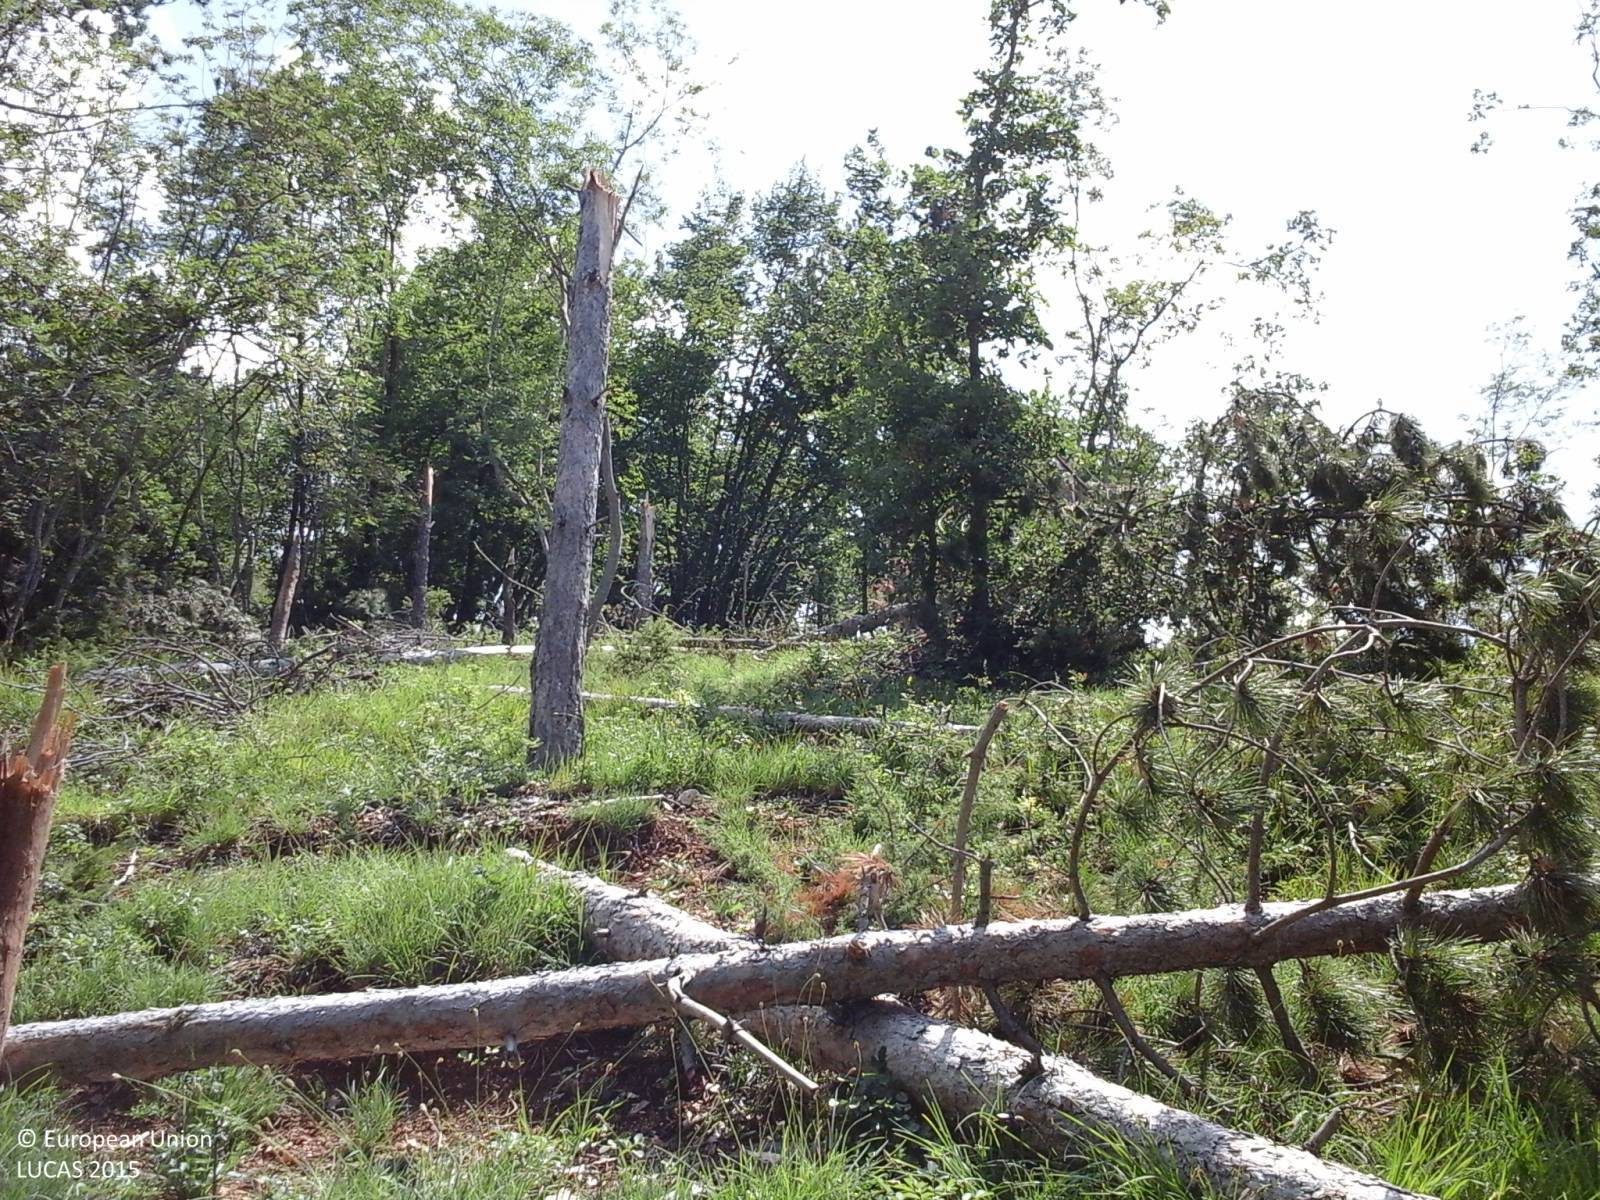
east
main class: Woodland
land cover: Broadleaved woodland
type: thermophilous deciduous forest
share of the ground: > 75 %
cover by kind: broadleaved forest trees 45 %, herbaceous plants 35 %, shrubs 15 %, coniferous forest trees 5 %
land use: Forestry
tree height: < 5 m
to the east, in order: Broadleaved woodland
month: June
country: IT
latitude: 42.1478
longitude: 13.3165
